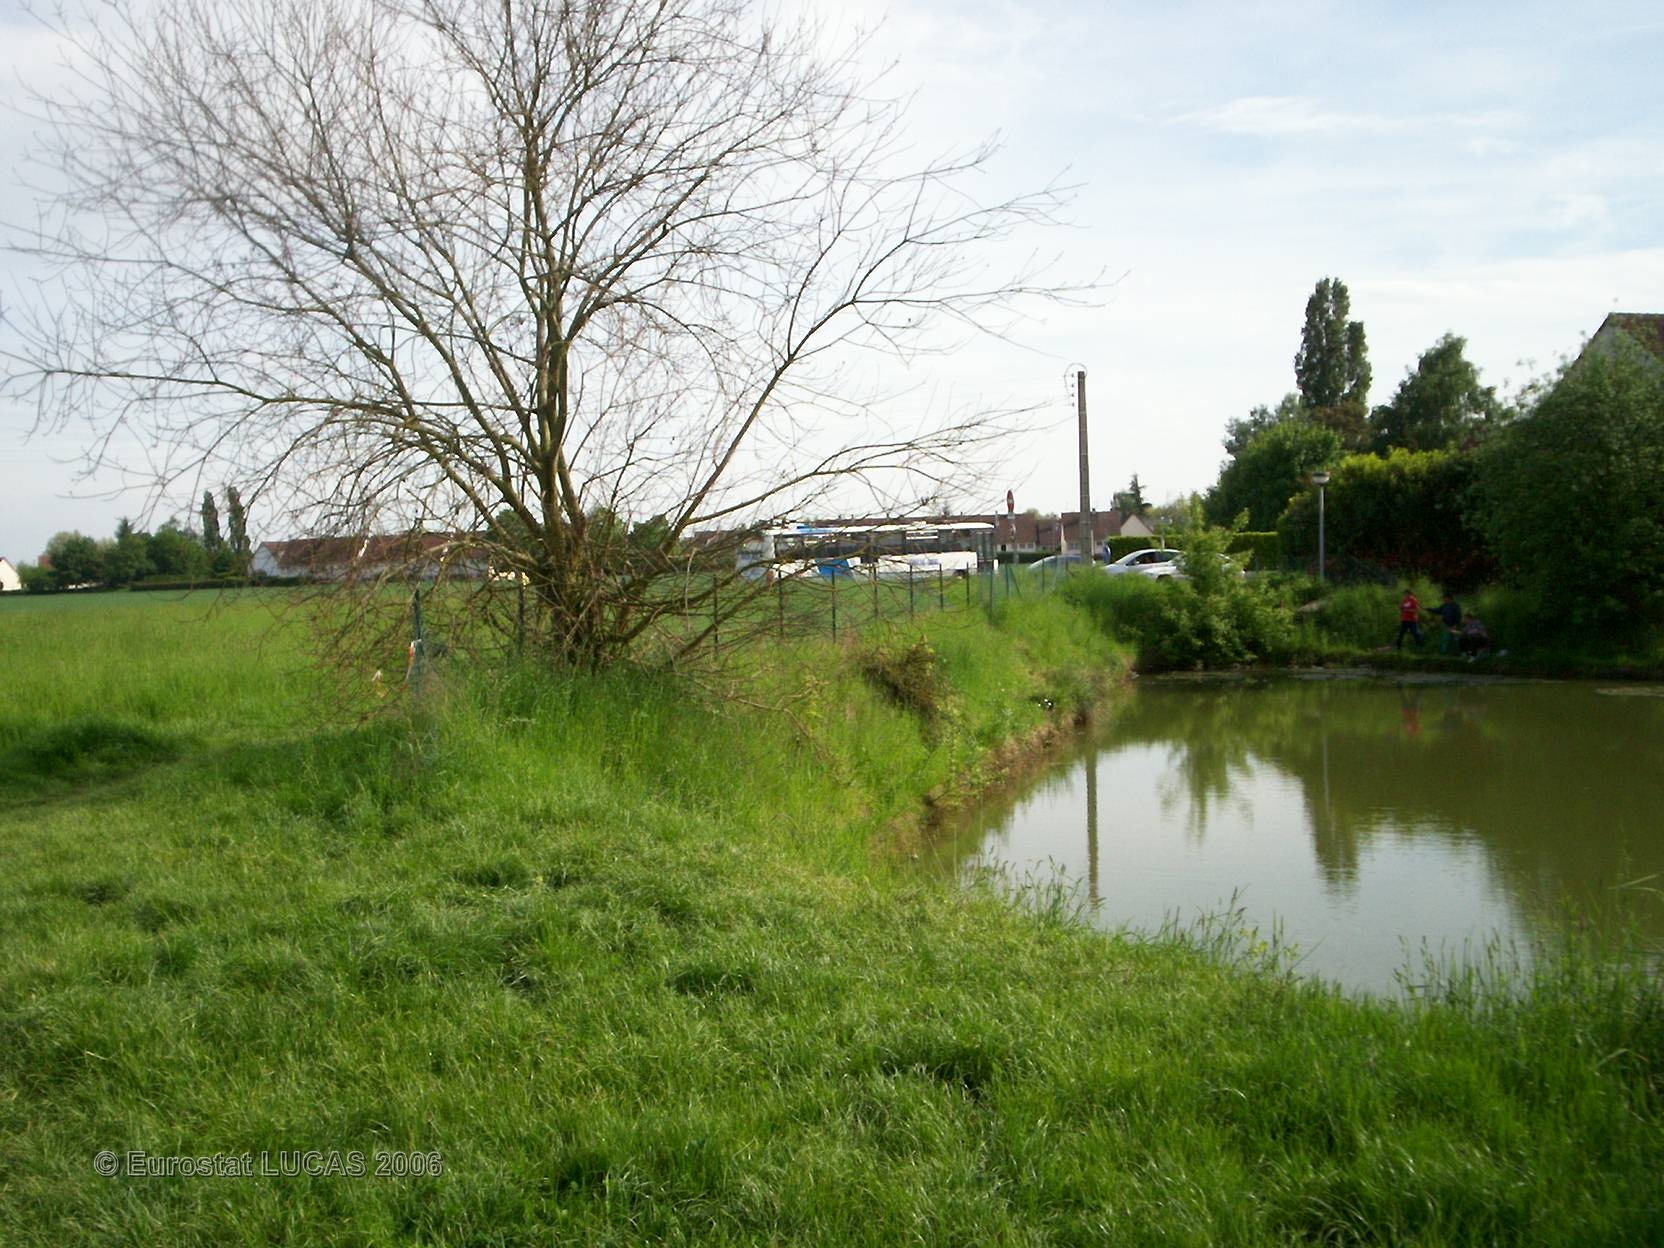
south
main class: Grassland
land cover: Grassland with sparse tree/shrub cover
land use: Amenities, museums, leisure
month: May
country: FR
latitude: 48.6085
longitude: 2.8979
